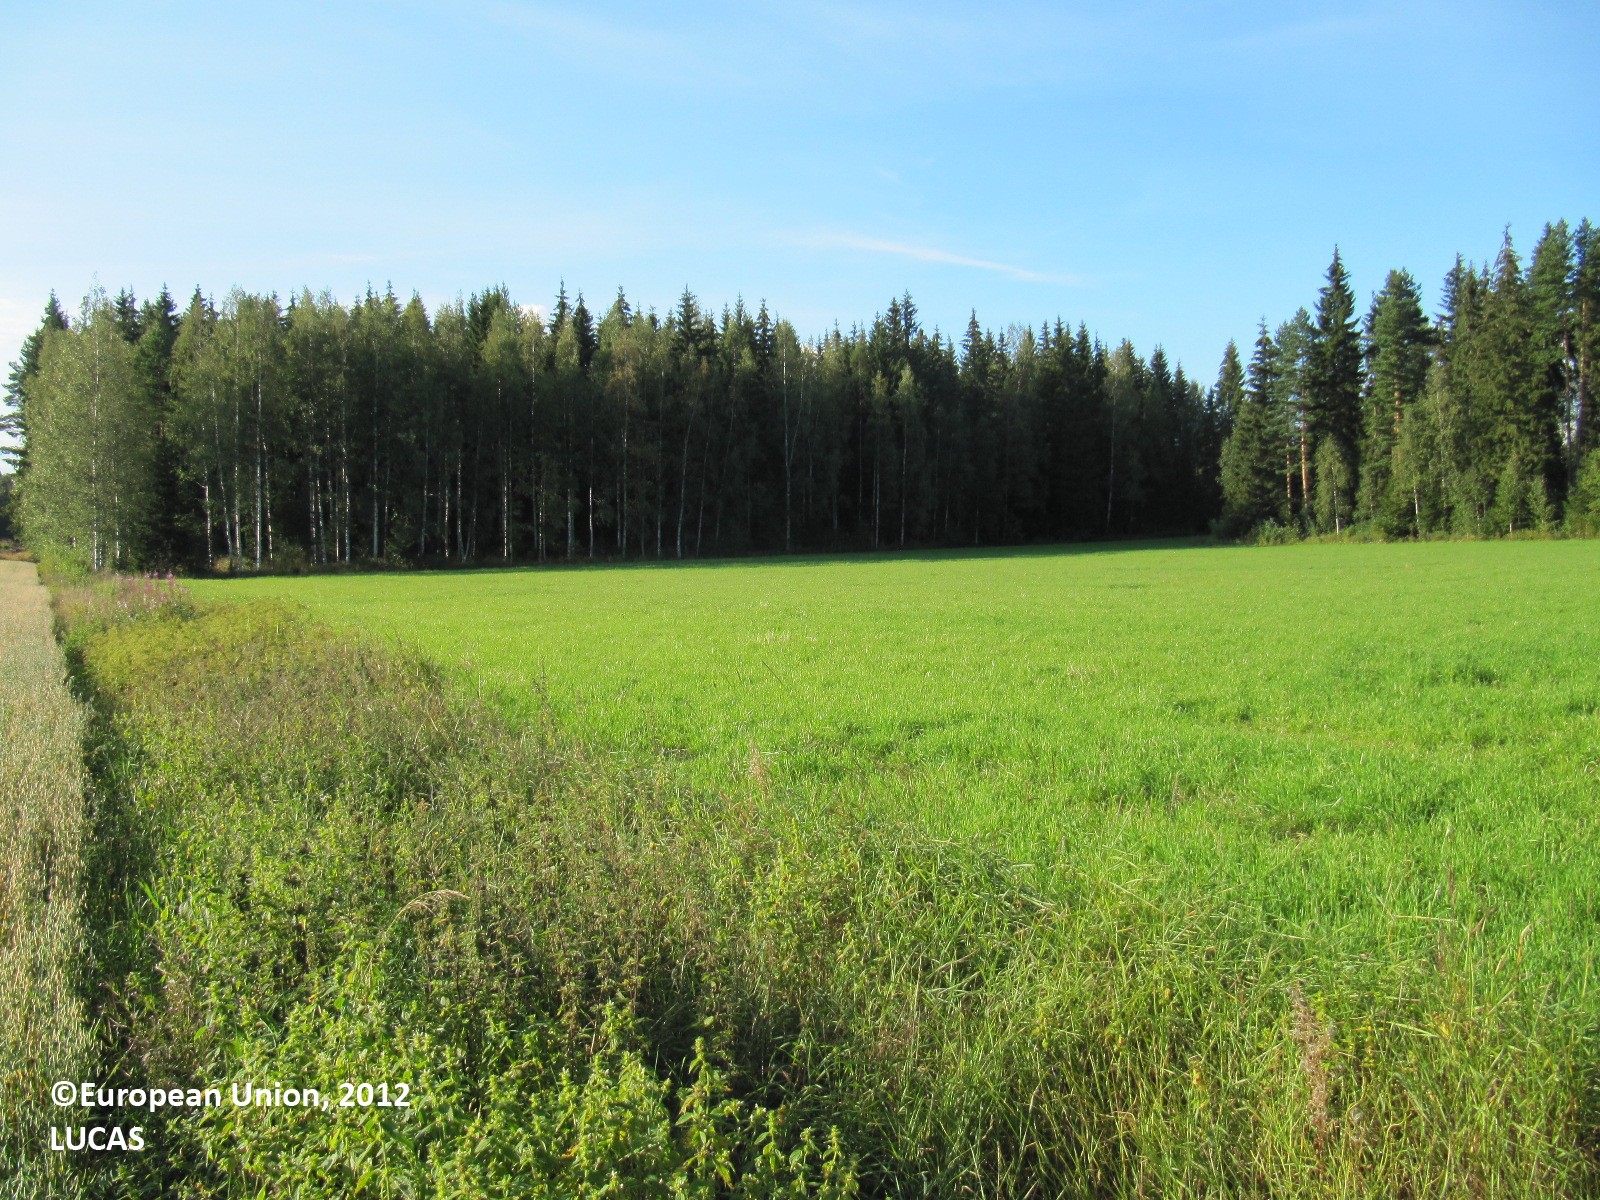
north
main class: Cropland
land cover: Oats
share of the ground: > 75 %
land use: Agriculture (excluding fallow land and kitchen gardens)
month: August
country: FI
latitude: 60.5499
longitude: 24.4548
